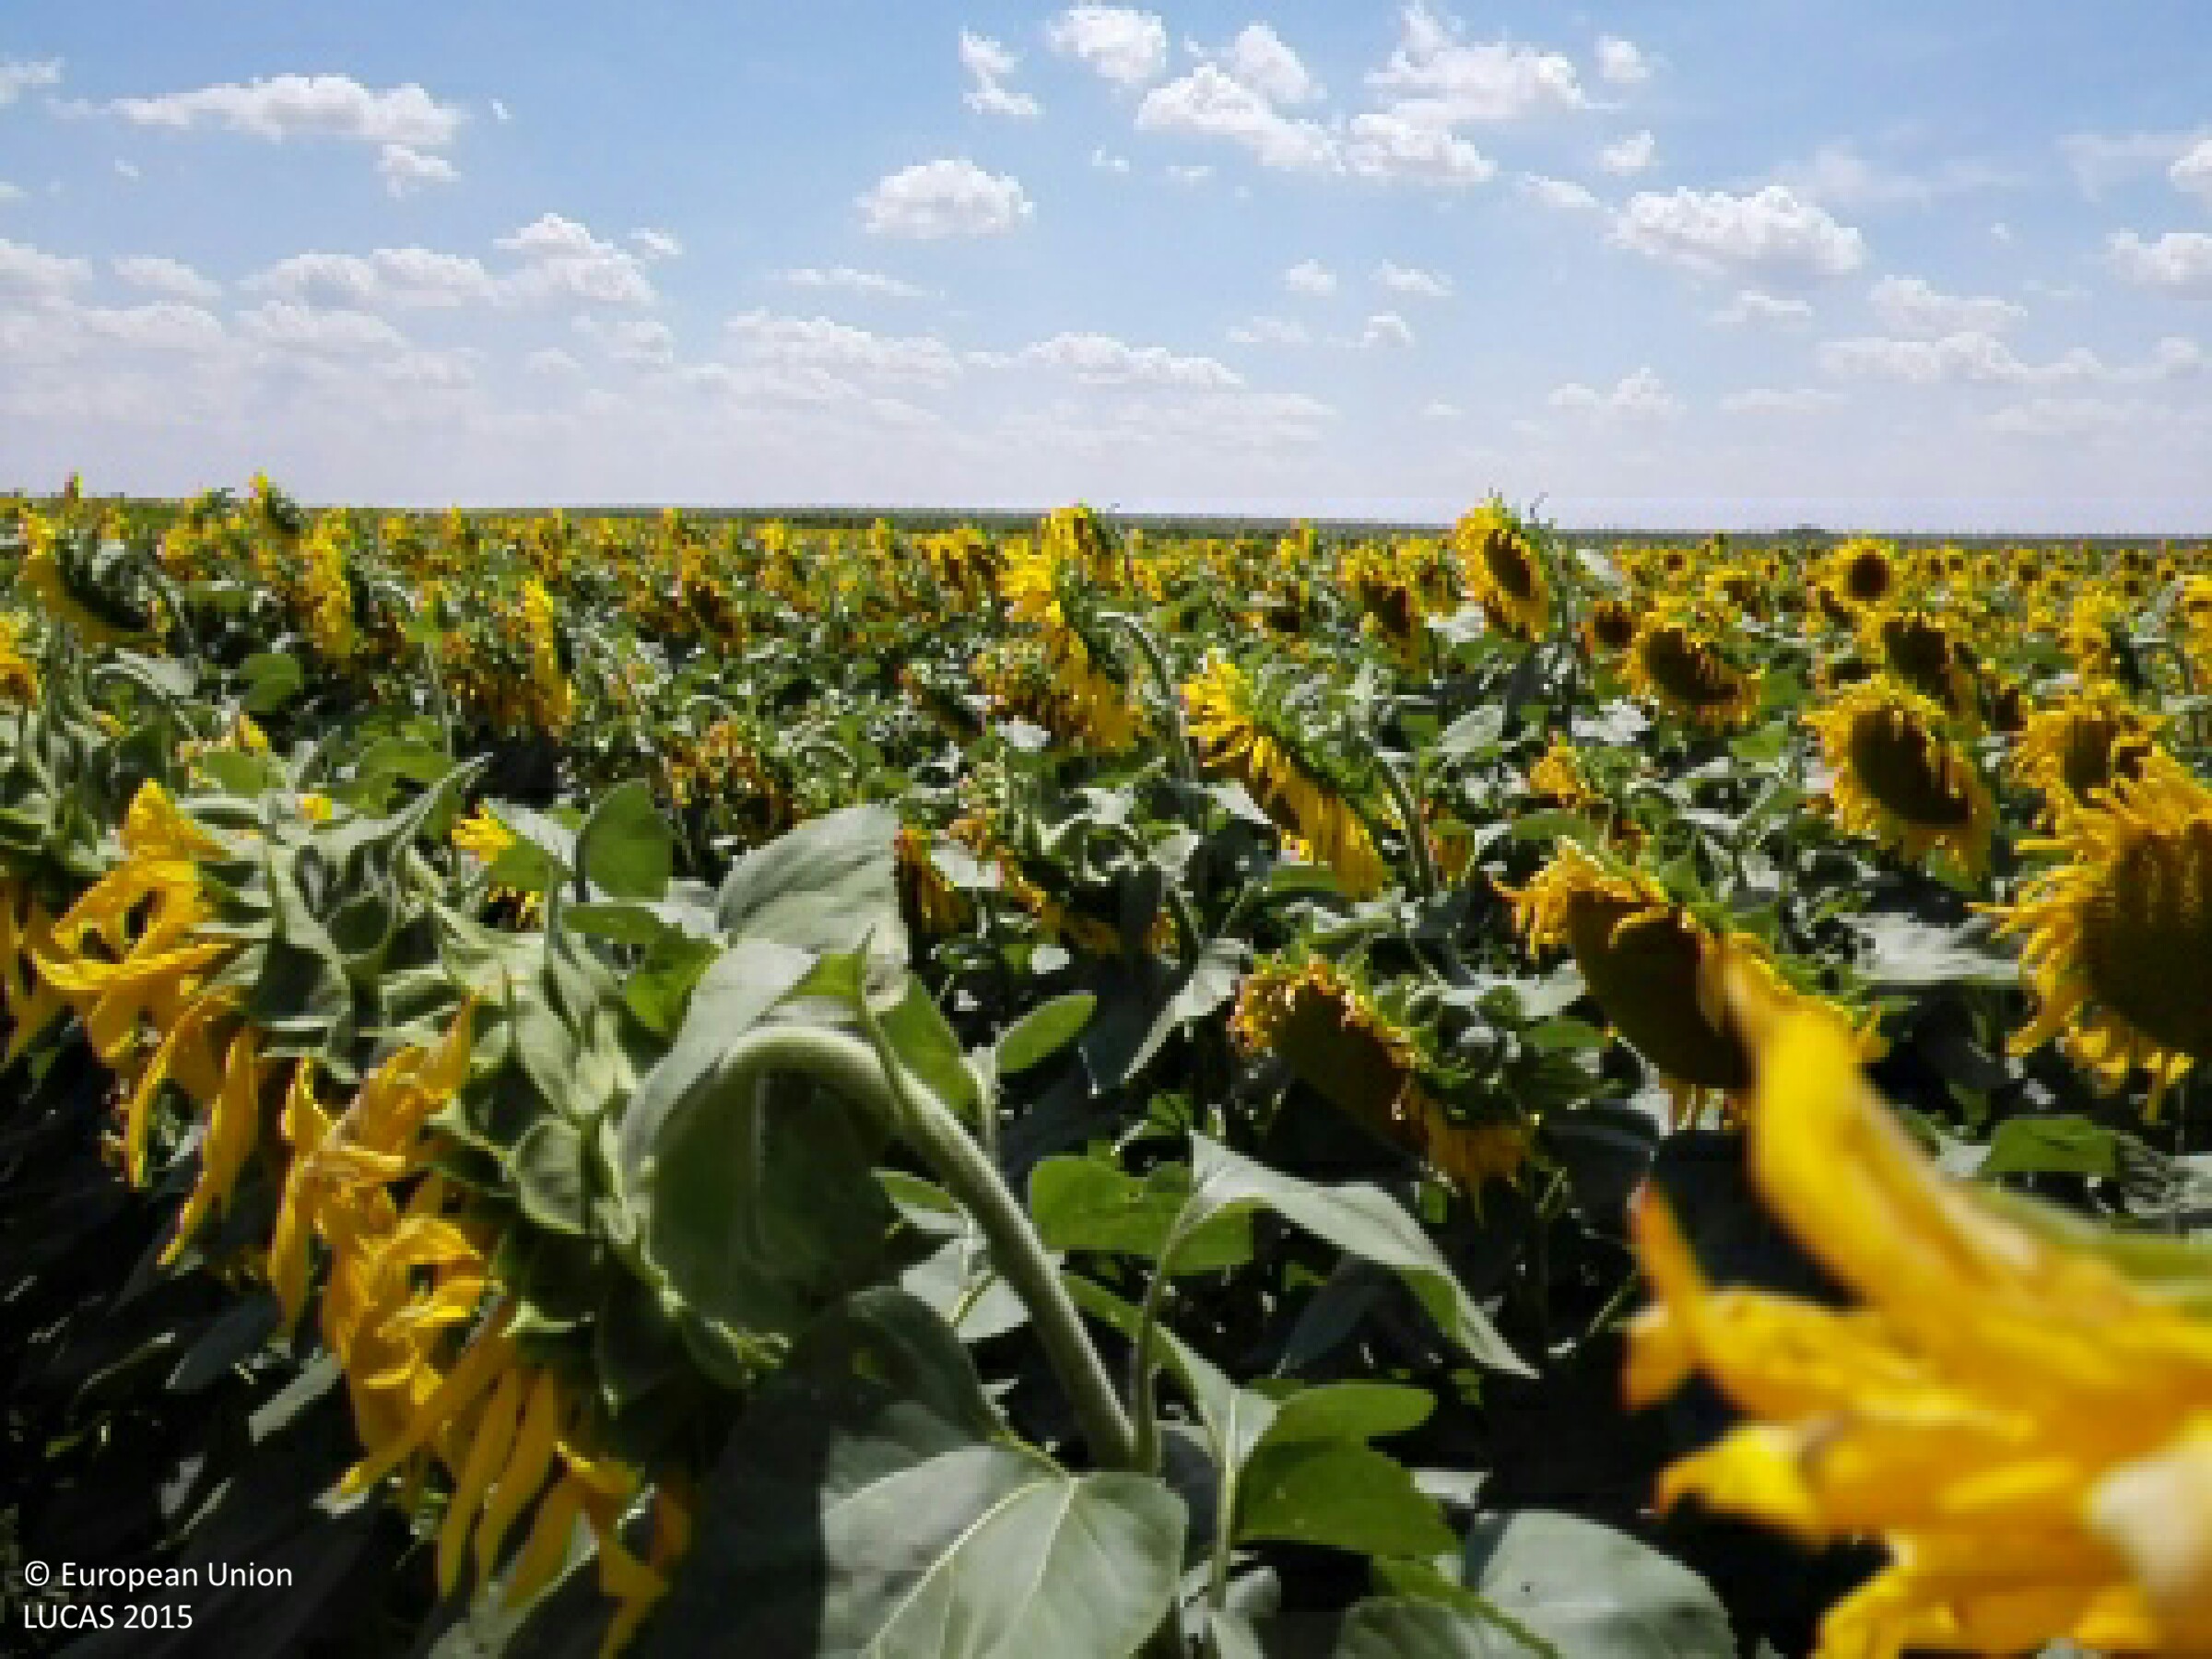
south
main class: Cropland
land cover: Sunflower
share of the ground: > 75 %
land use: Agriculture (excluding fallow land and kitchen gardens)
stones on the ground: < 10 %
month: July
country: HU
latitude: 47.4203
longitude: 21.3204
